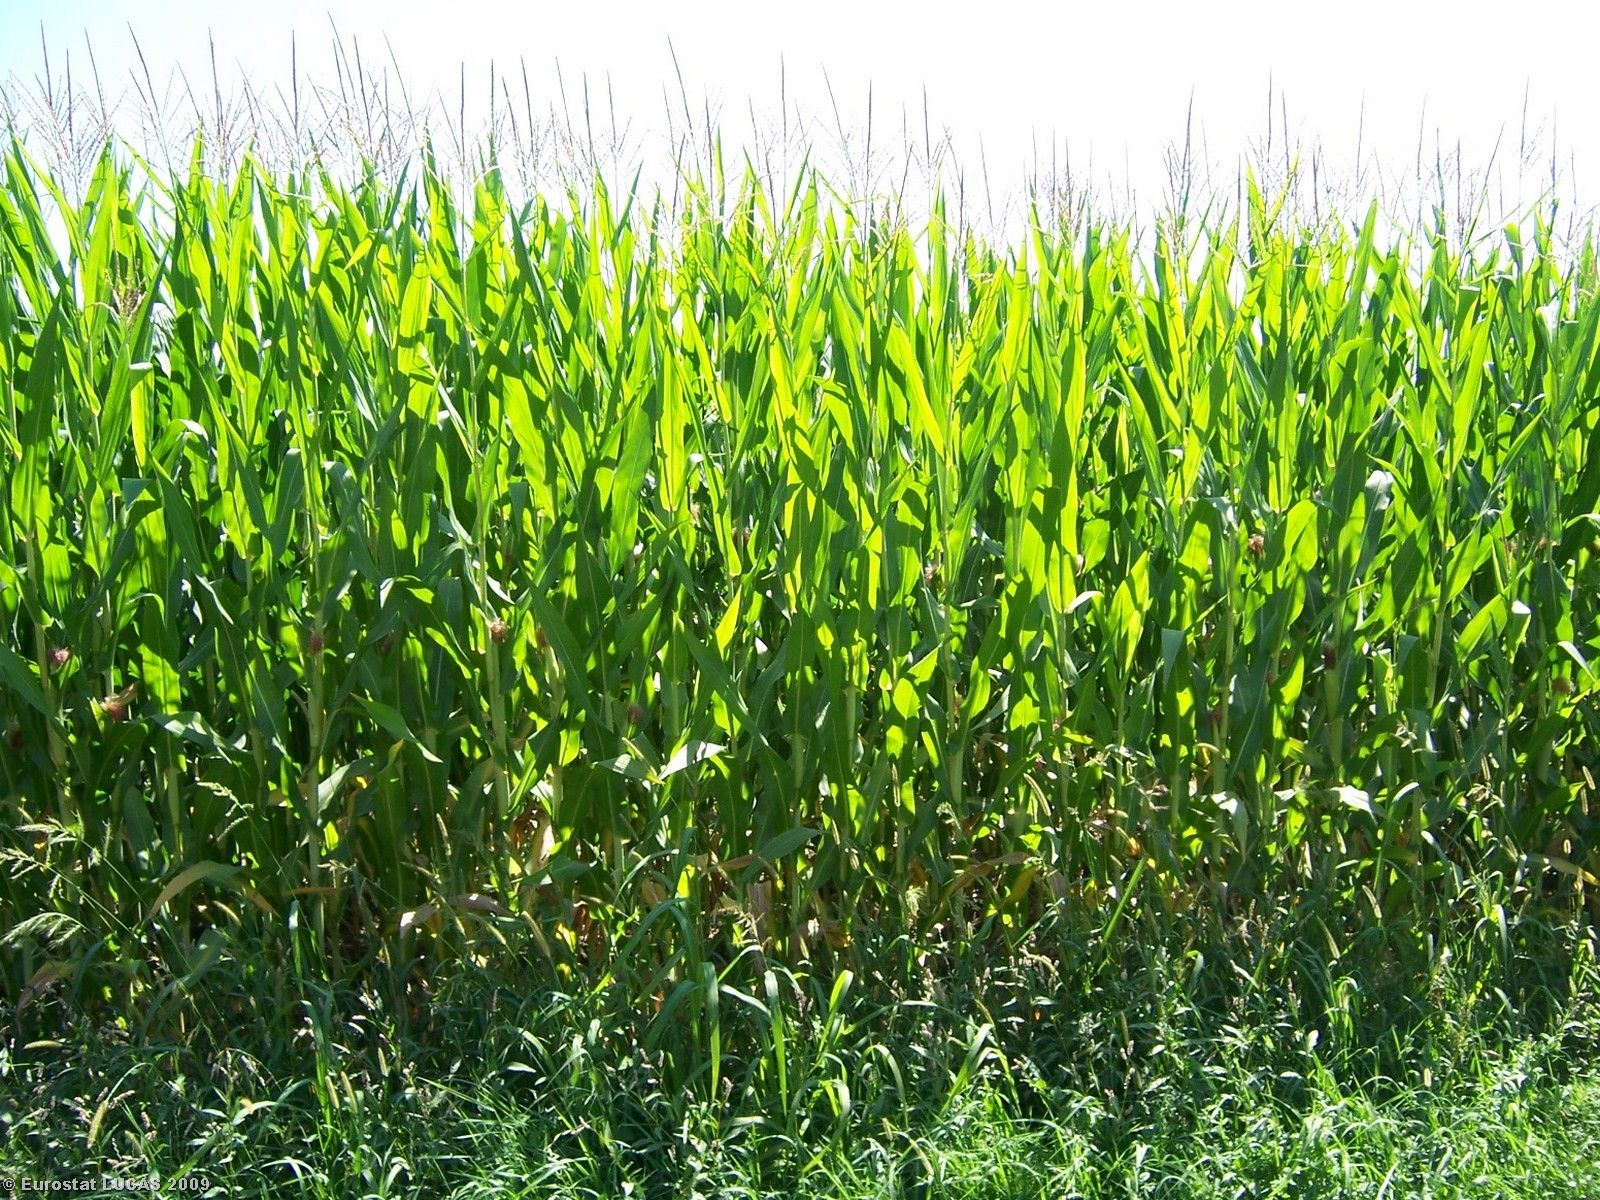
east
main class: Cropland
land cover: Maize
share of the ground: > 75 %
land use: Agriculture (excluding fallow land and kitchen gardens)
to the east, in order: Maize; Grass margins; Tracks; Grass margins; Maize
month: July
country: IT
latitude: 44.8775
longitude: 7.4096
